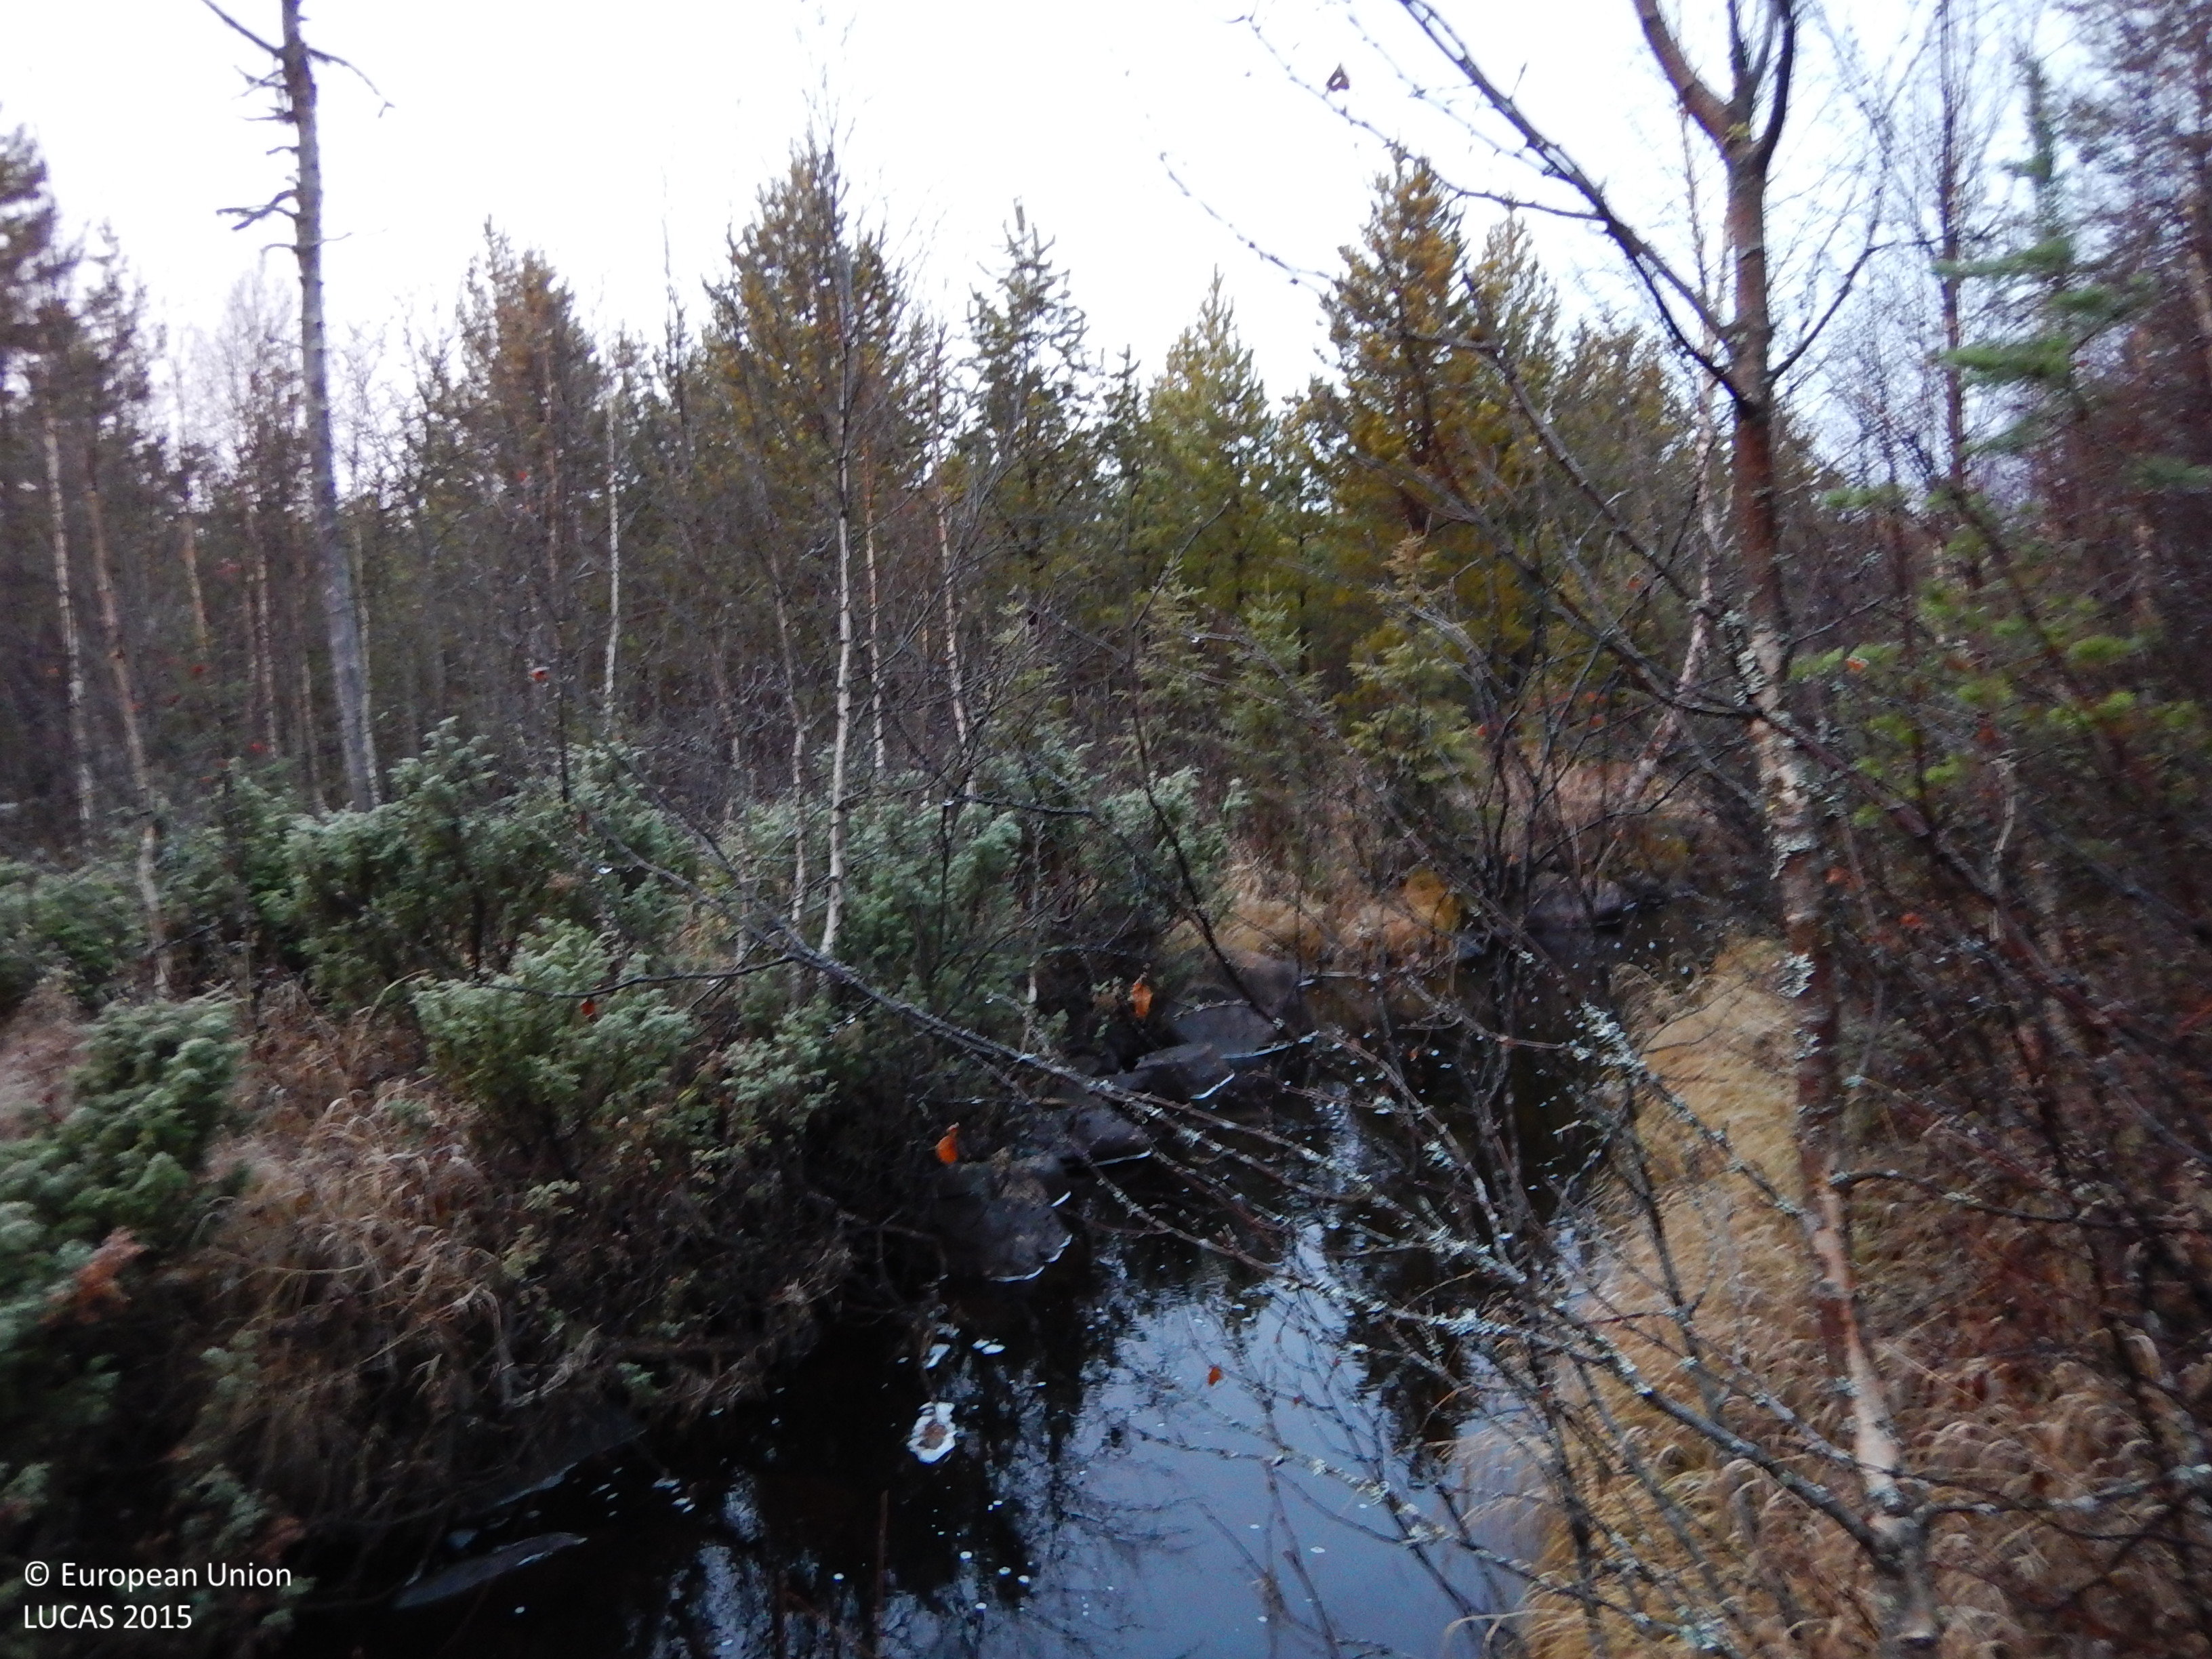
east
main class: Woodland
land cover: Broadleaved woodland
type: mire and swamp forests
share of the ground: 25 - 50 %
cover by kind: broadleaved forest trees 35 %, shrubs 20 %, herbaceous plants 20 %, lichens and mosses 20 %, coniferous forest trees 5 %
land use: Forestry
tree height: > 5 m
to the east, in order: Broadleaved woodland; Rivers and streams; Broadleaved woodland; Spruce dominated coniferous woodland; Tracks; Grass margins; Ditches and canals; Spruce dominated mixed woodland; Spruce dominated coniferous woodland
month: November
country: SE
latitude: 65.1457
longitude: 20.4828
